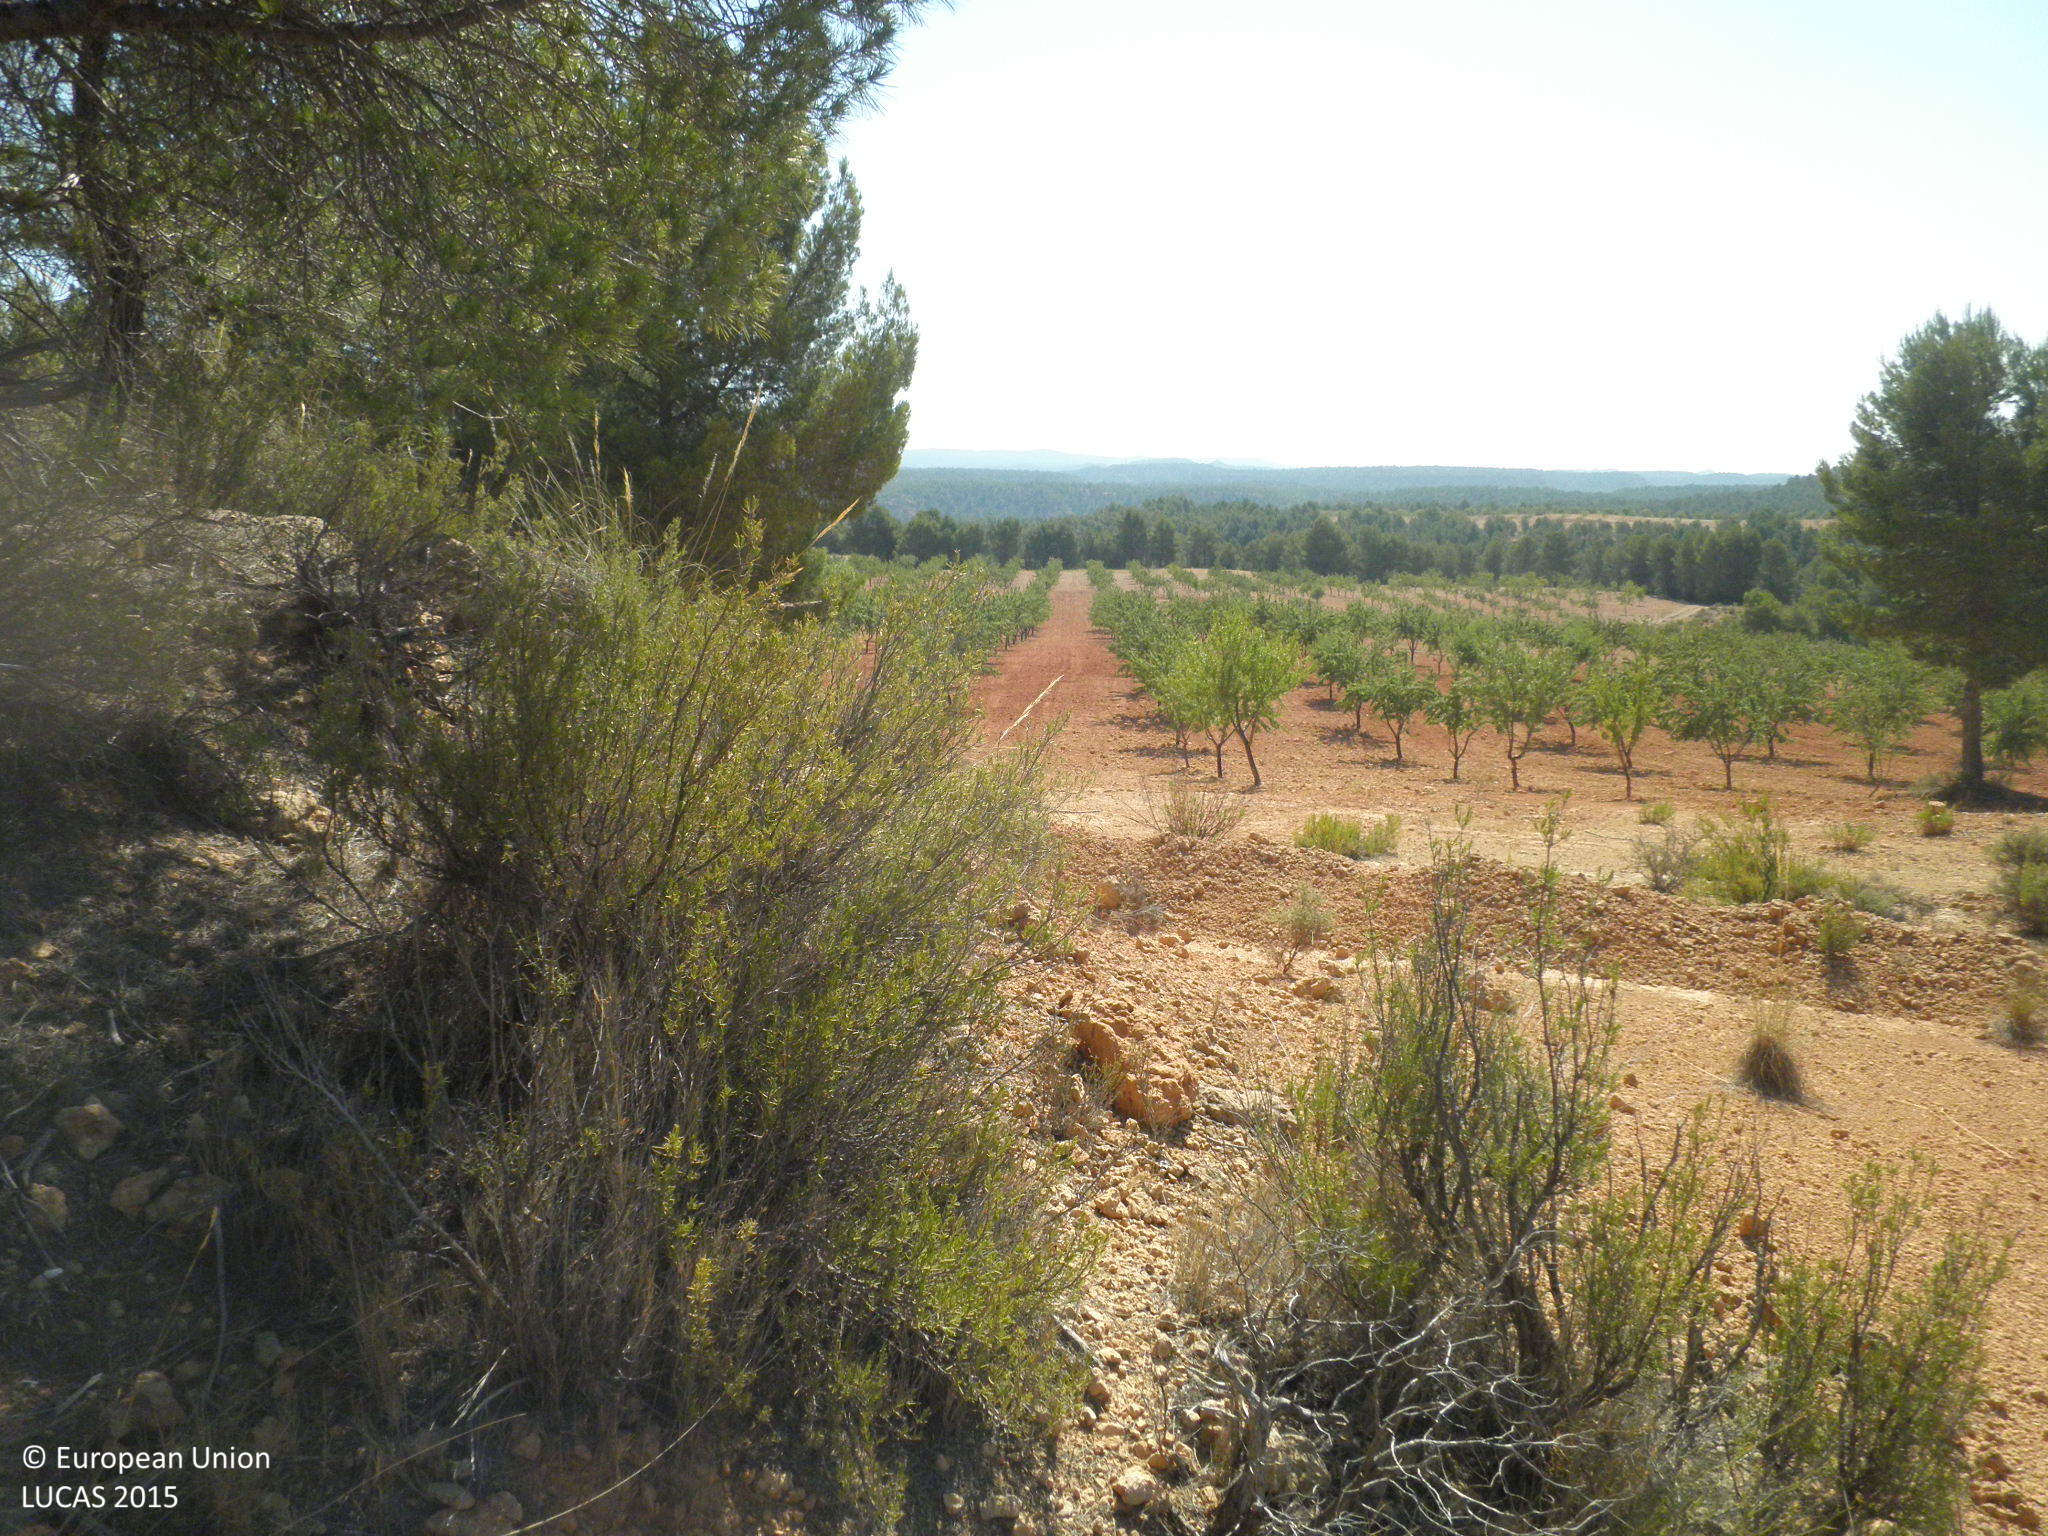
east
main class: Woodland
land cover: Pine dominated coniferous woodland
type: coniferous forest of the mediterranean region
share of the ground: 10 - 25 %
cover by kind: unconsolidated bare surface 60 %, shrubs 20 %, coniferous forest trees 10 %, herbaceous plants 10 %
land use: Semi-natural and natural areas not in use
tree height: < 5 m
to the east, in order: Pine dominated coniferous woodland; Shrubland with sparse tree cover; Nuts trees
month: July
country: ES
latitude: 39.4378
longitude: -1.5408
